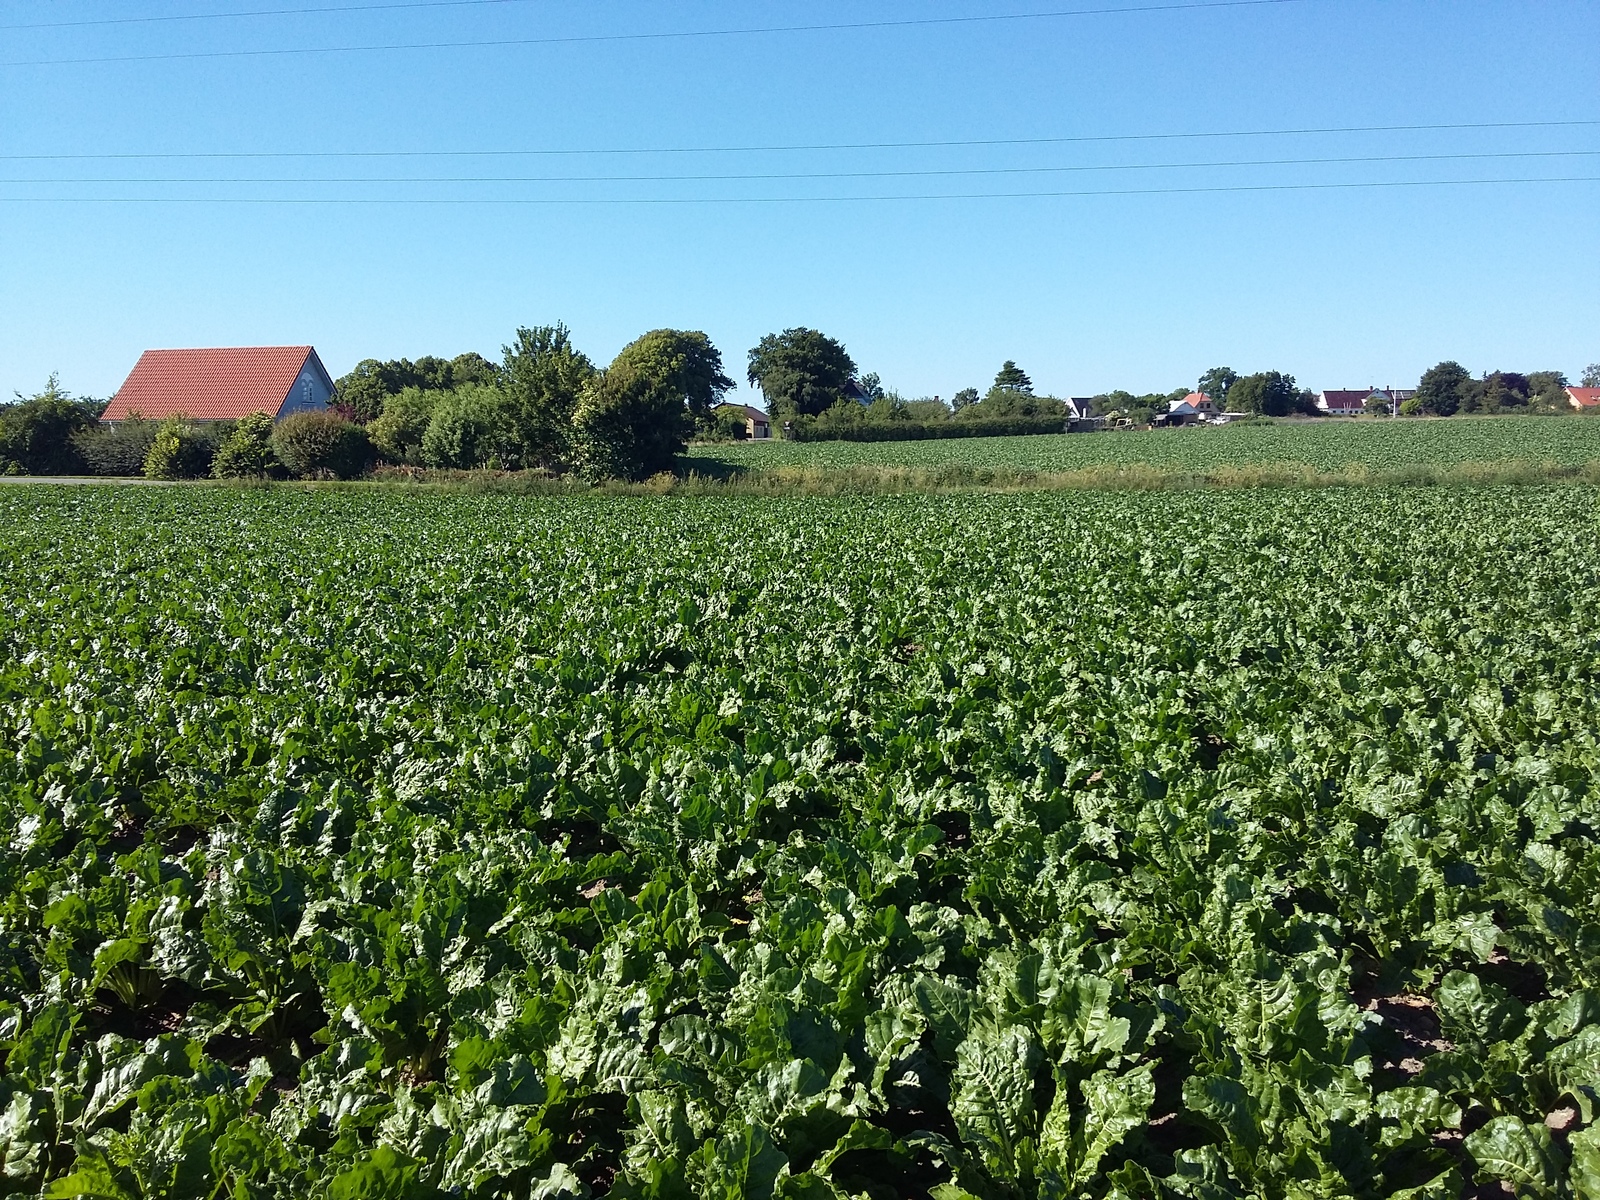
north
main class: Cropland
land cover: Sugar beet
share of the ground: > 75 %
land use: Agriculture (excluding fallow land and kitchen gardens)
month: July
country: DK
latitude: 54.9636
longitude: 12.2321
